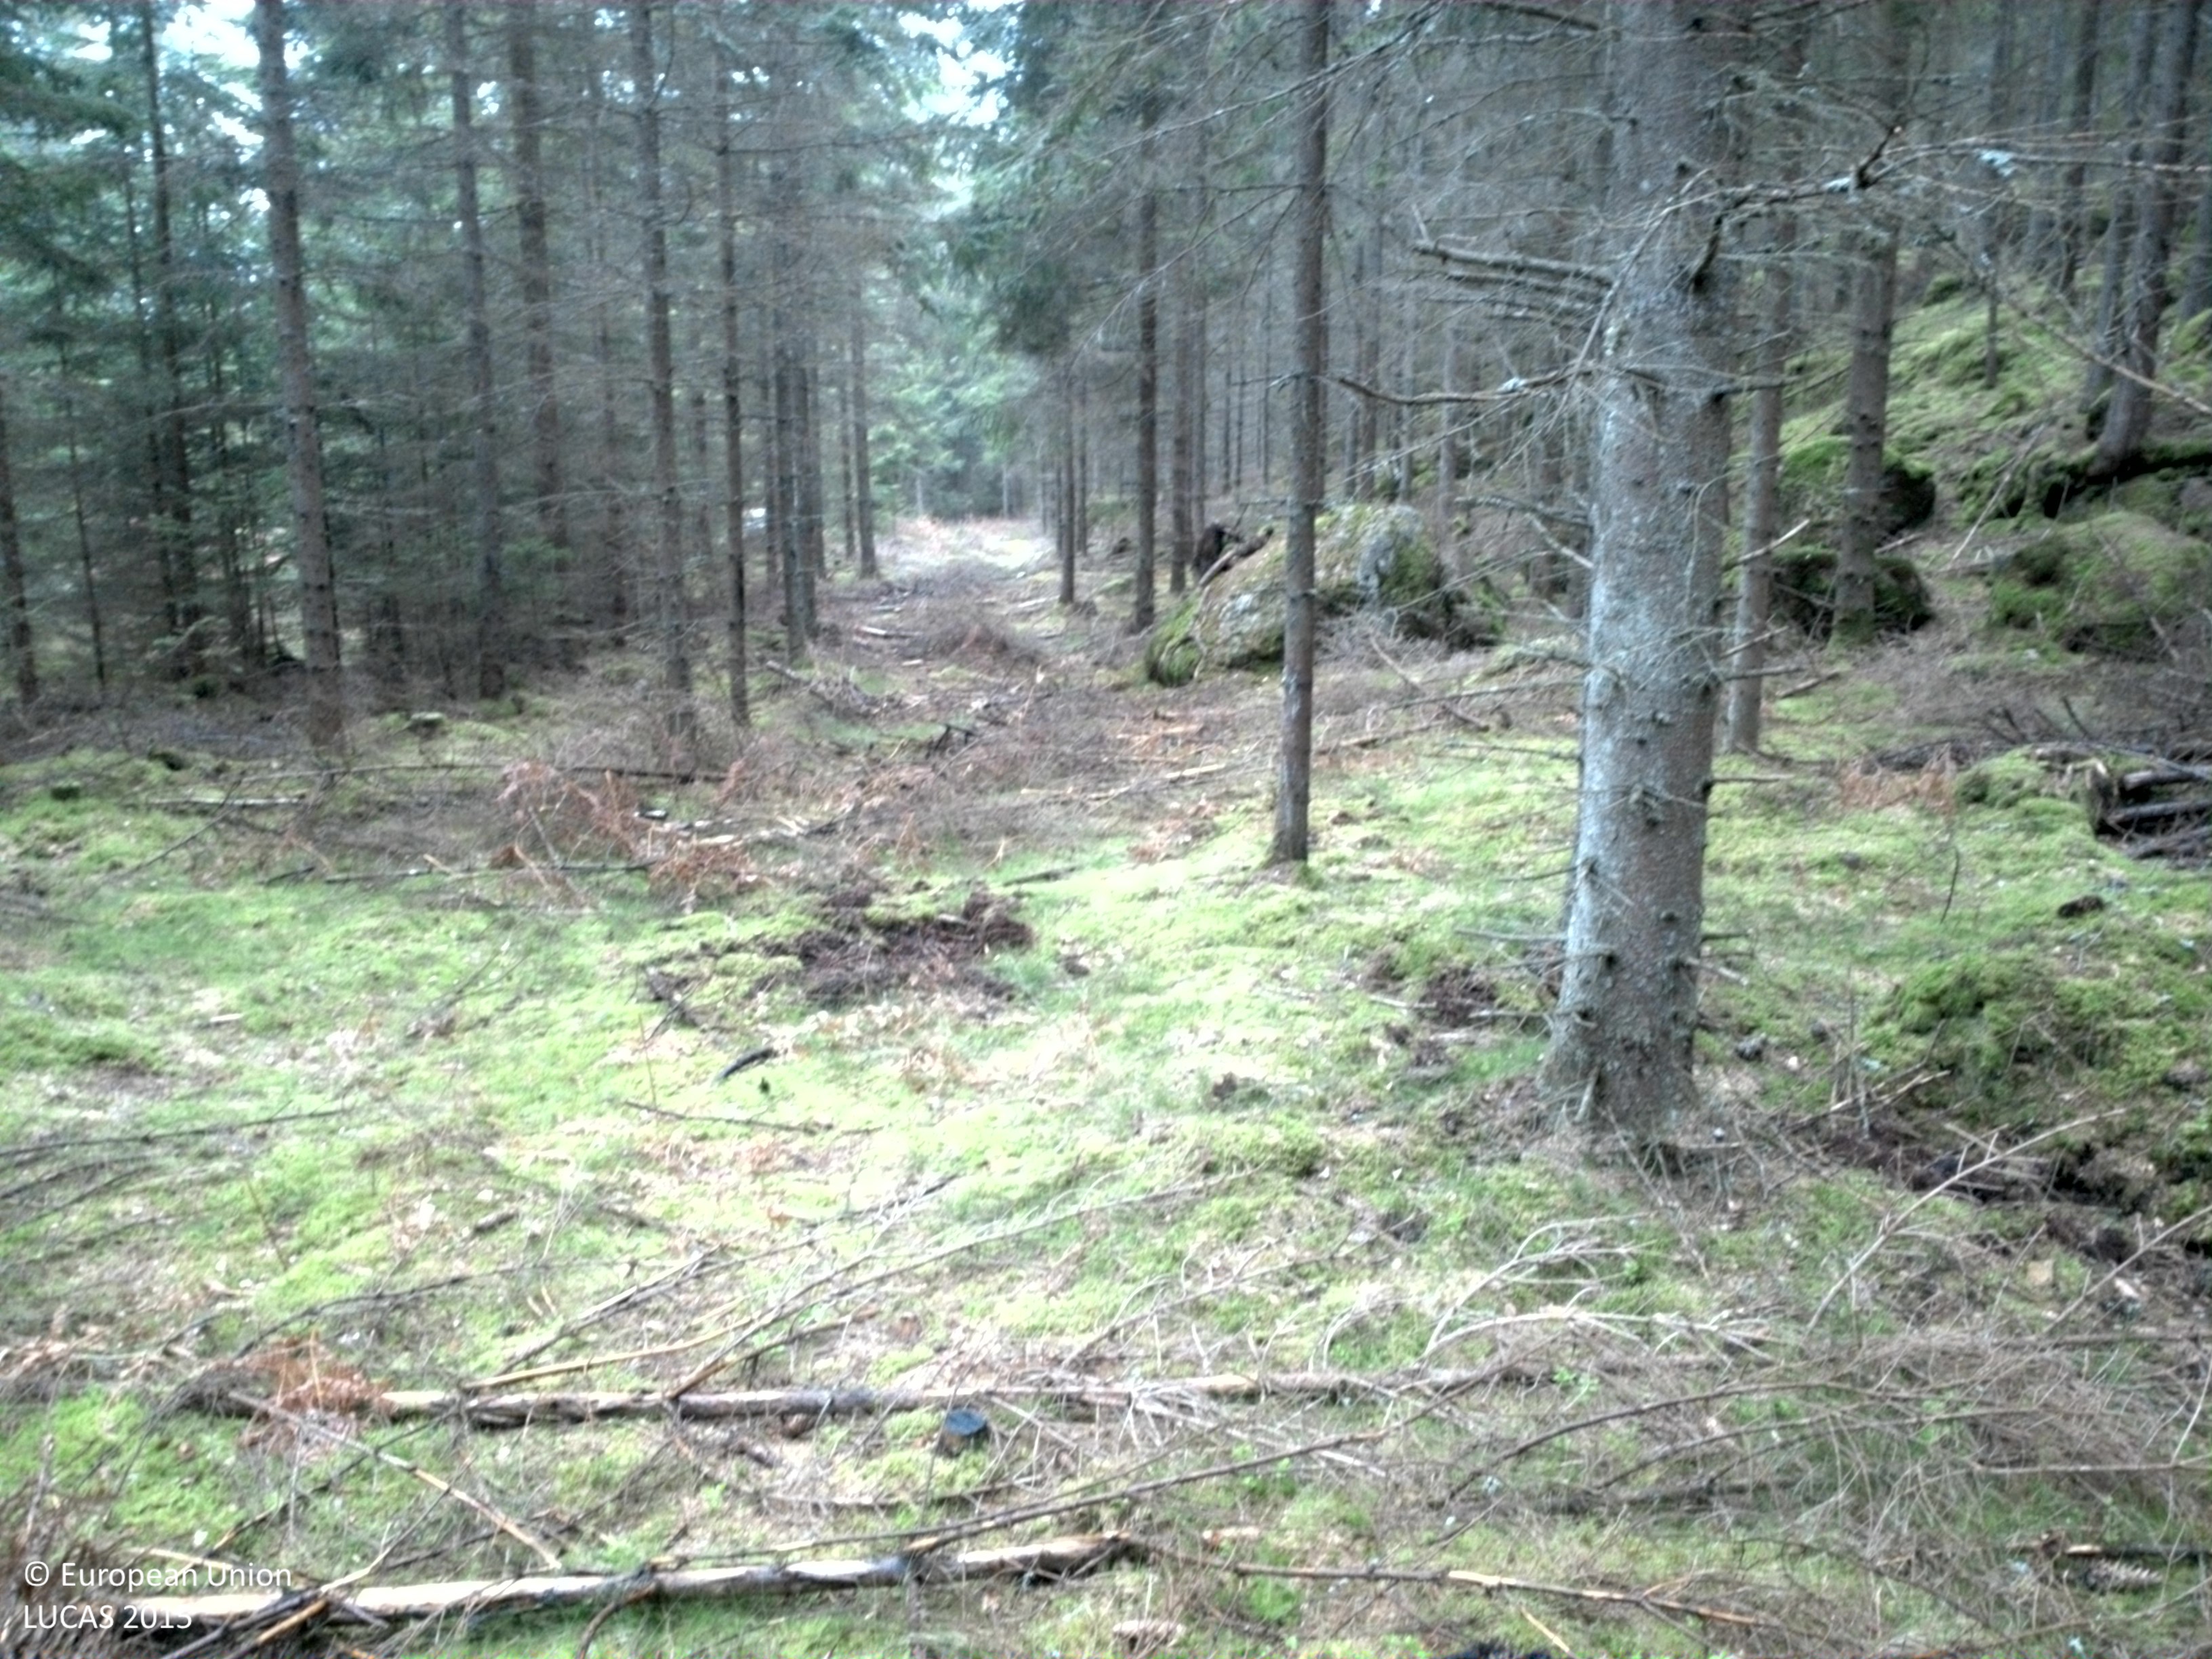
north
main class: Woodland
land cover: Spruce dominated coniferous woodland
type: boreal forest
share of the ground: > 75 %
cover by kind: coniferous forest trees 95 %, lichens and mosses 5 %
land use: Forestry
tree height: > 5 m
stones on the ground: 10 - 25 %
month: May
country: SE
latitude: 56.3809
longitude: 15.3918
